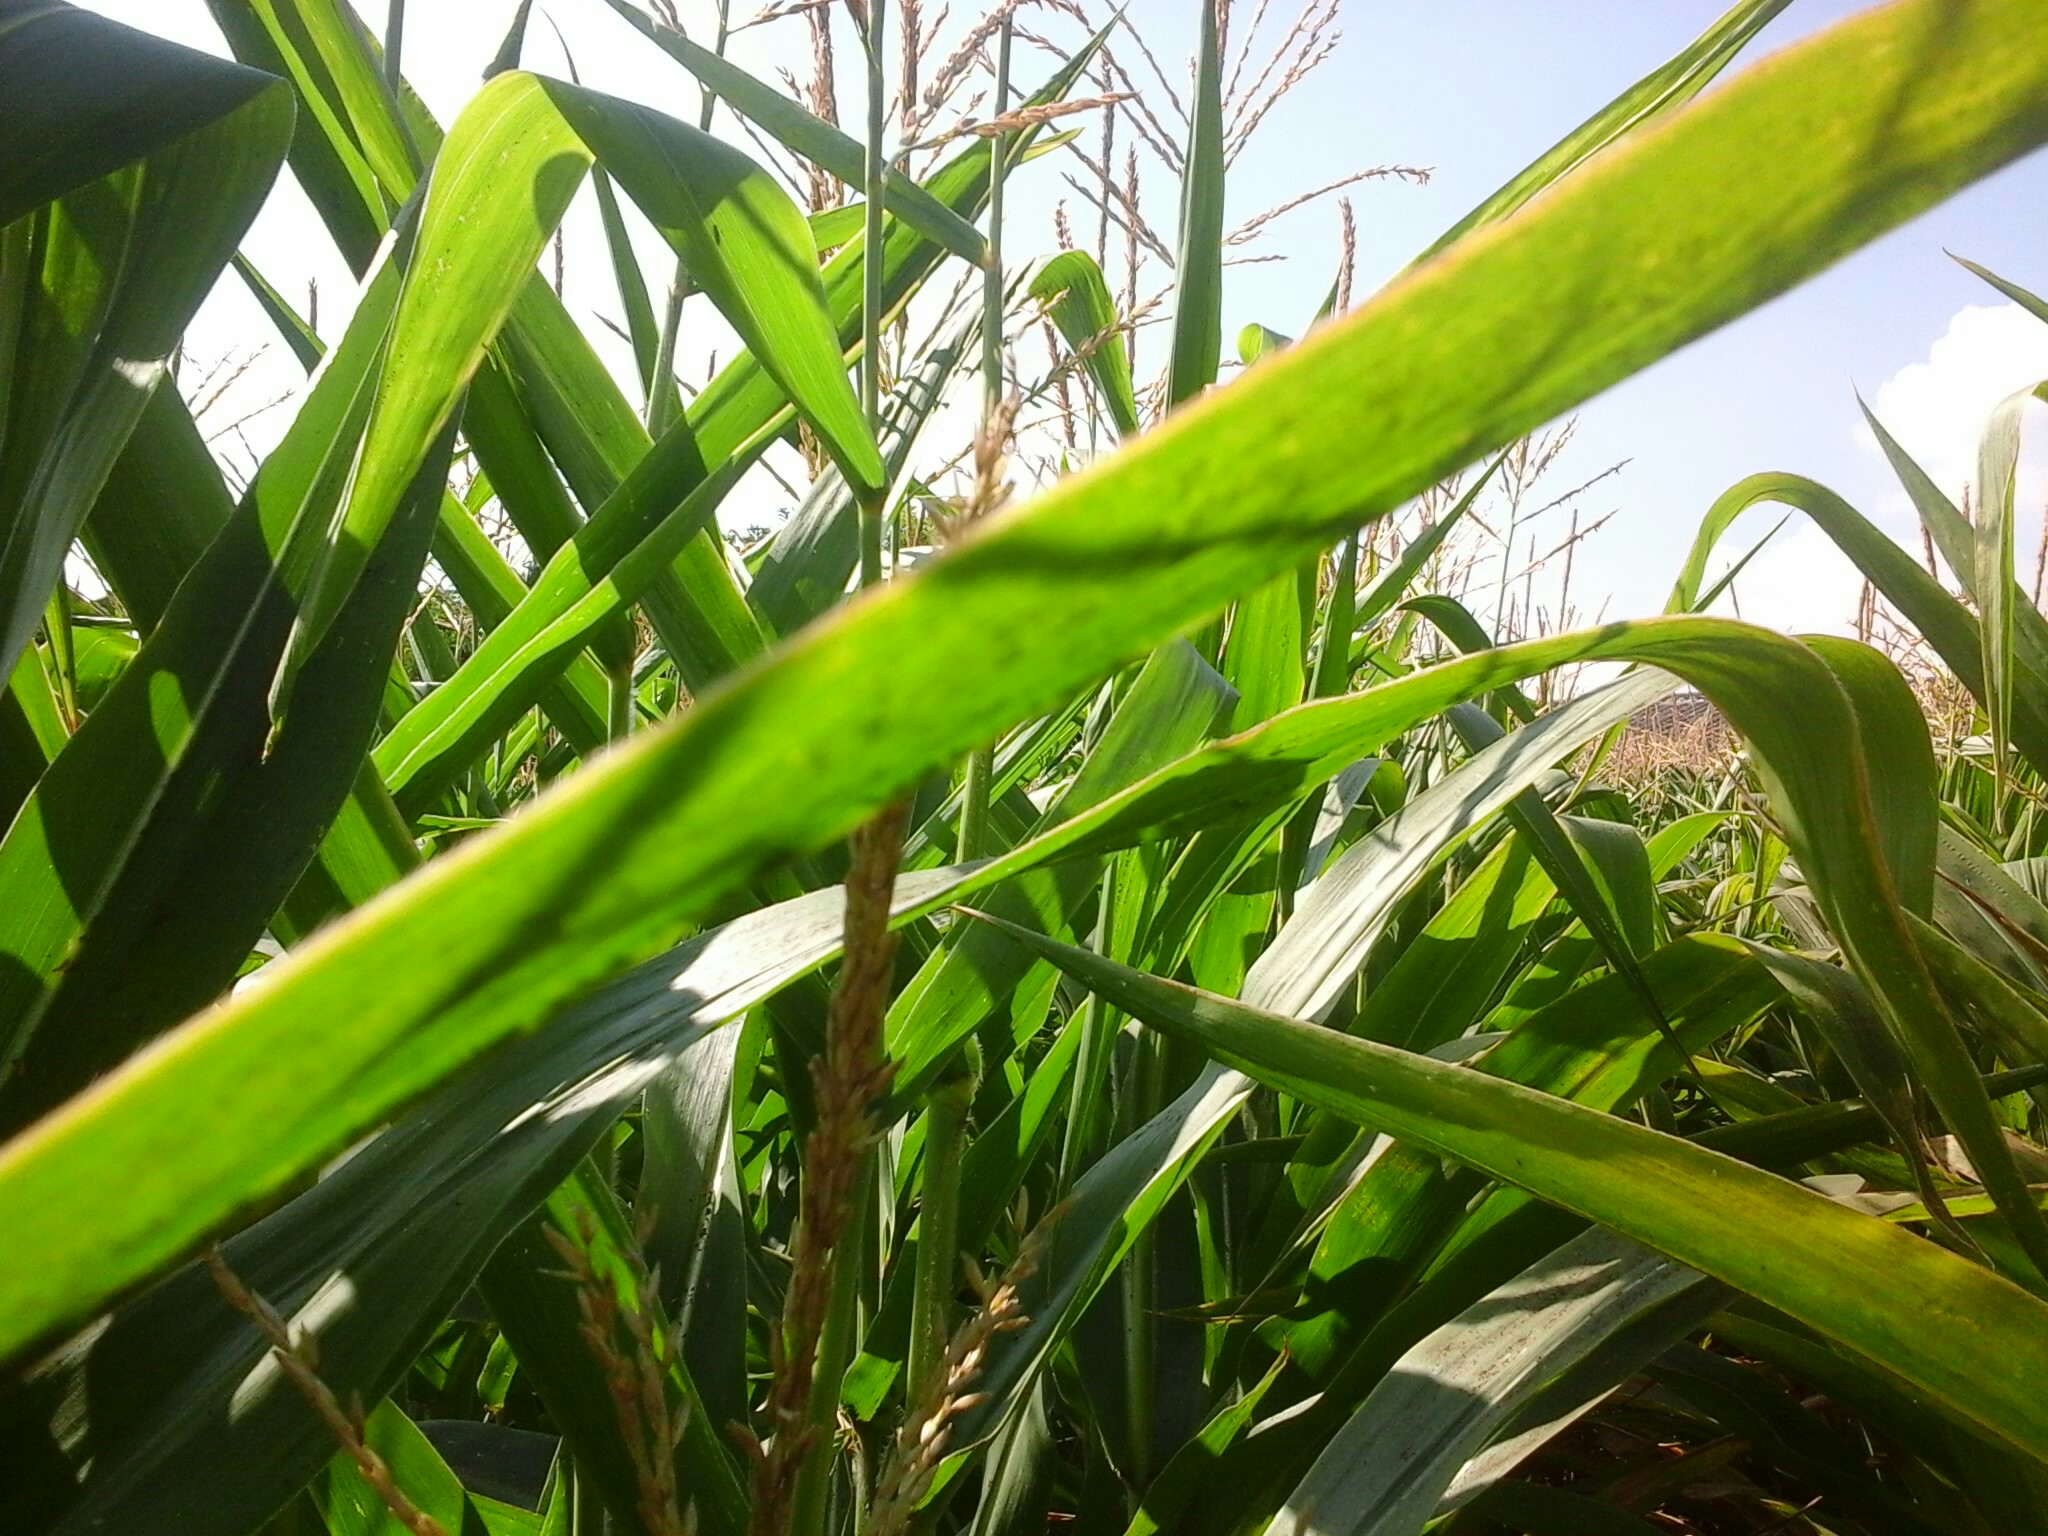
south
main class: Cropland
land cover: Maize
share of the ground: > 75 %
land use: Agriculture (excluding fallow land and kitchen gardens)
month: August
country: HU
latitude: 47.6501
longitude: 17.9053
